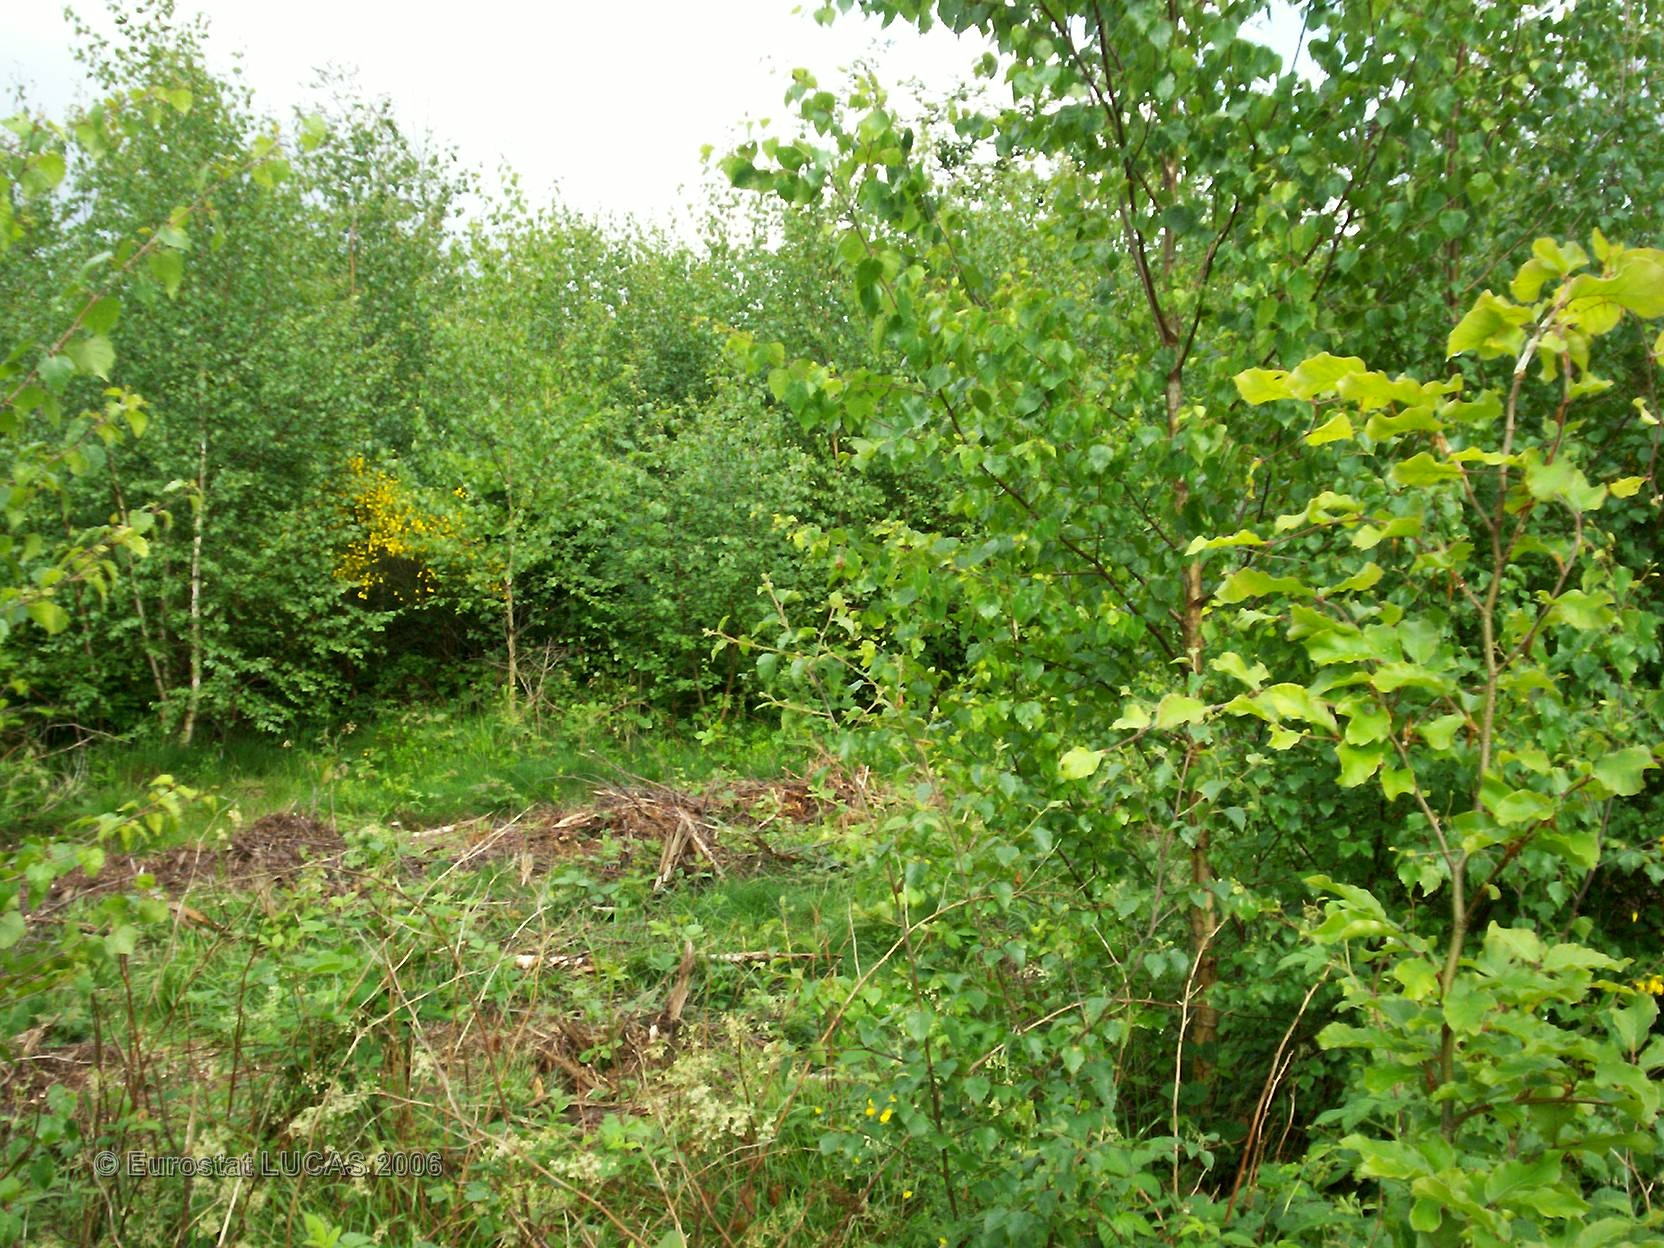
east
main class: Woodland
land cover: Broadleaved forest
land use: Forestry
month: May
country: FR
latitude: 48.5236
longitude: 6.9542
